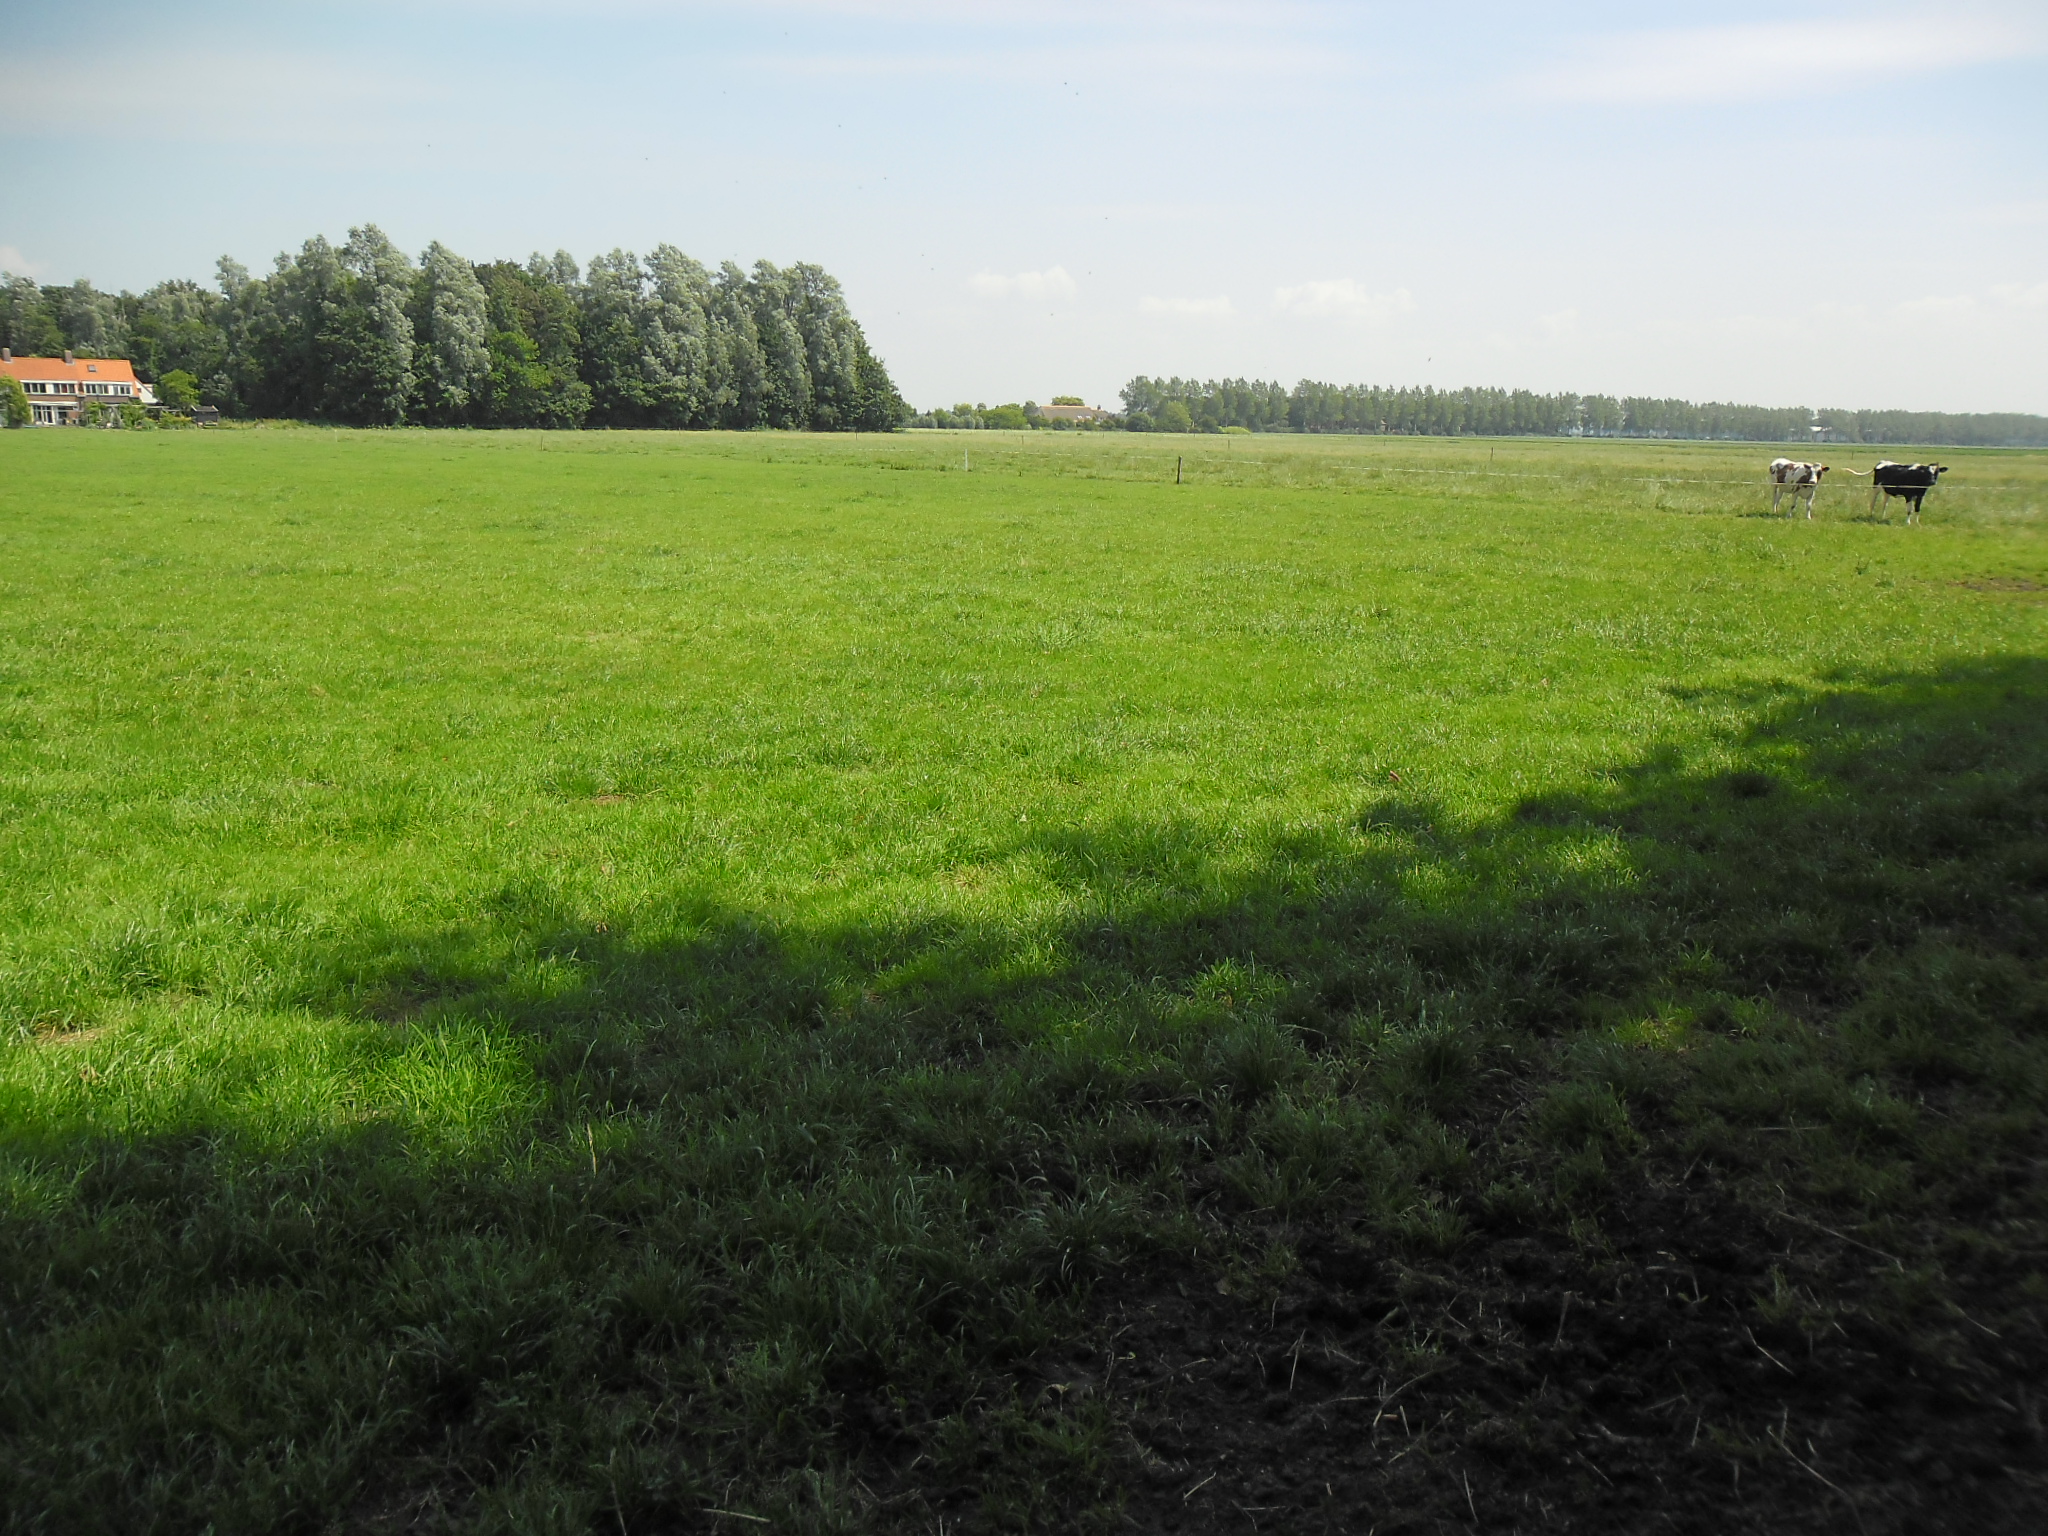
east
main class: Grassland
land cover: Grassland without tree/shrub cover
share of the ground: > 75 %
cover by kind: herbaceous plants 100 %
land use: Agriculture (excluding fallow land and kitchen gardens)
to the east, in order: Broadleaved woodland; Grassland without tree/shrub cover; Fences; Grassland without tree/shrub cover; Fences; Grassland without tree/shrub cover; Fences; Ditches and canals; Shruby margins; Ditches and canals
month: July
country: NL
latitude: 52.6753
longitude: 5.6358
